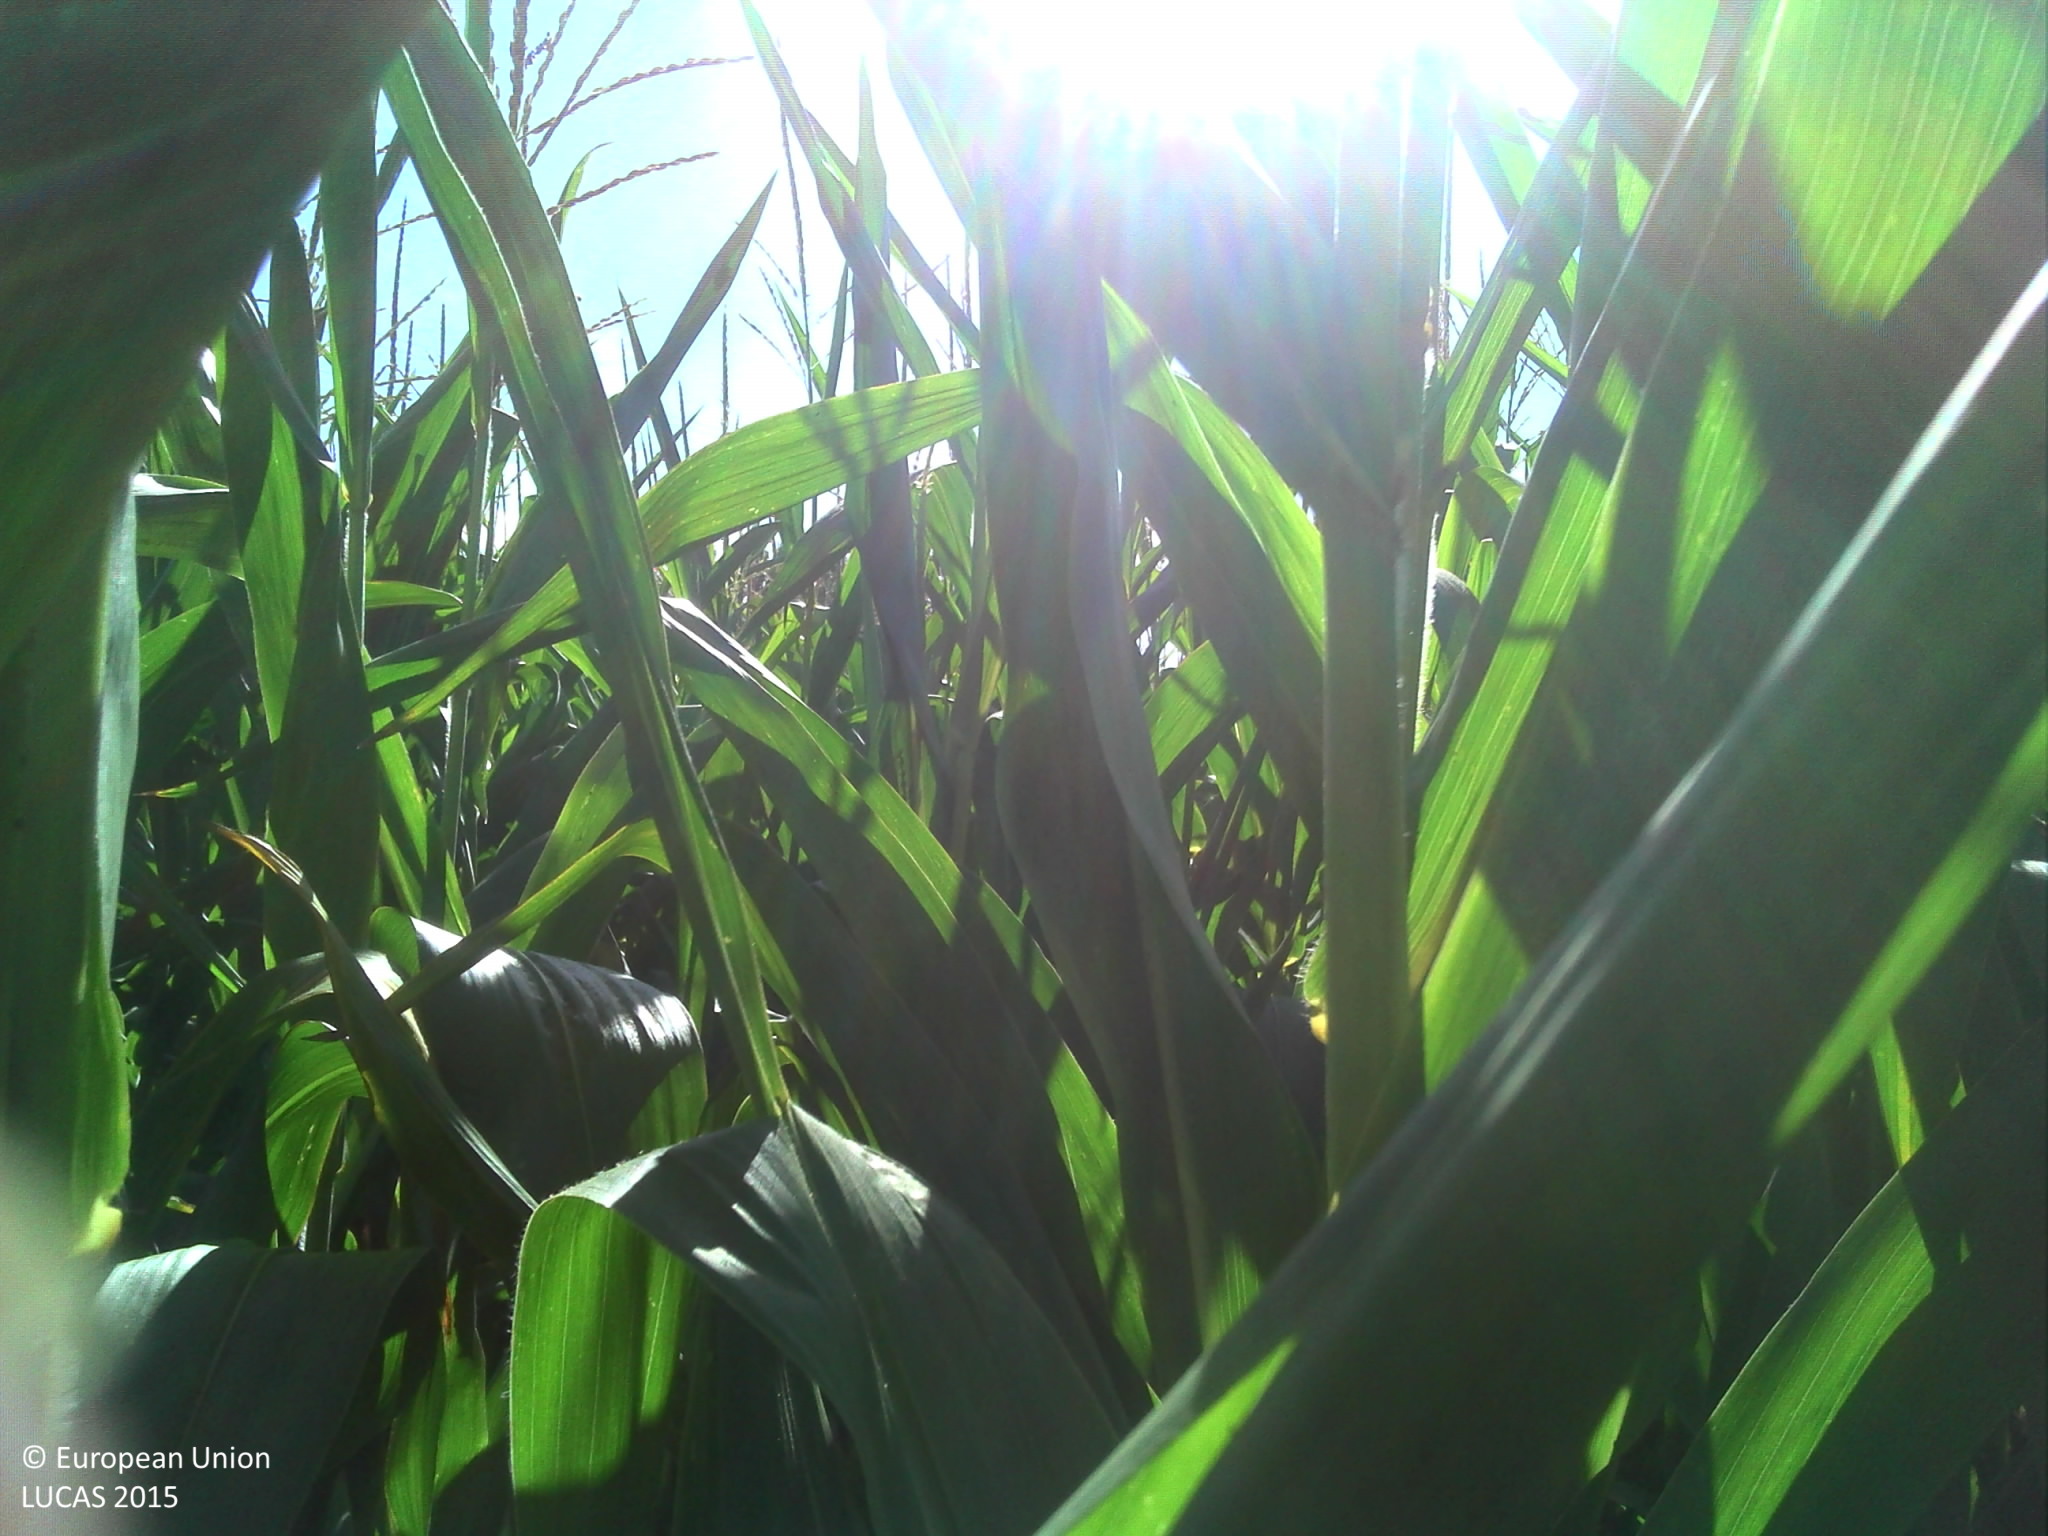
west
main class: Cropland
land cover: Maize
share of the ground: > 75 %
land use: Agriculture (excluding fallow land and kitchen gardens)
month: August
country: FR
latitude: 46.7438
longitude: -1.3591
